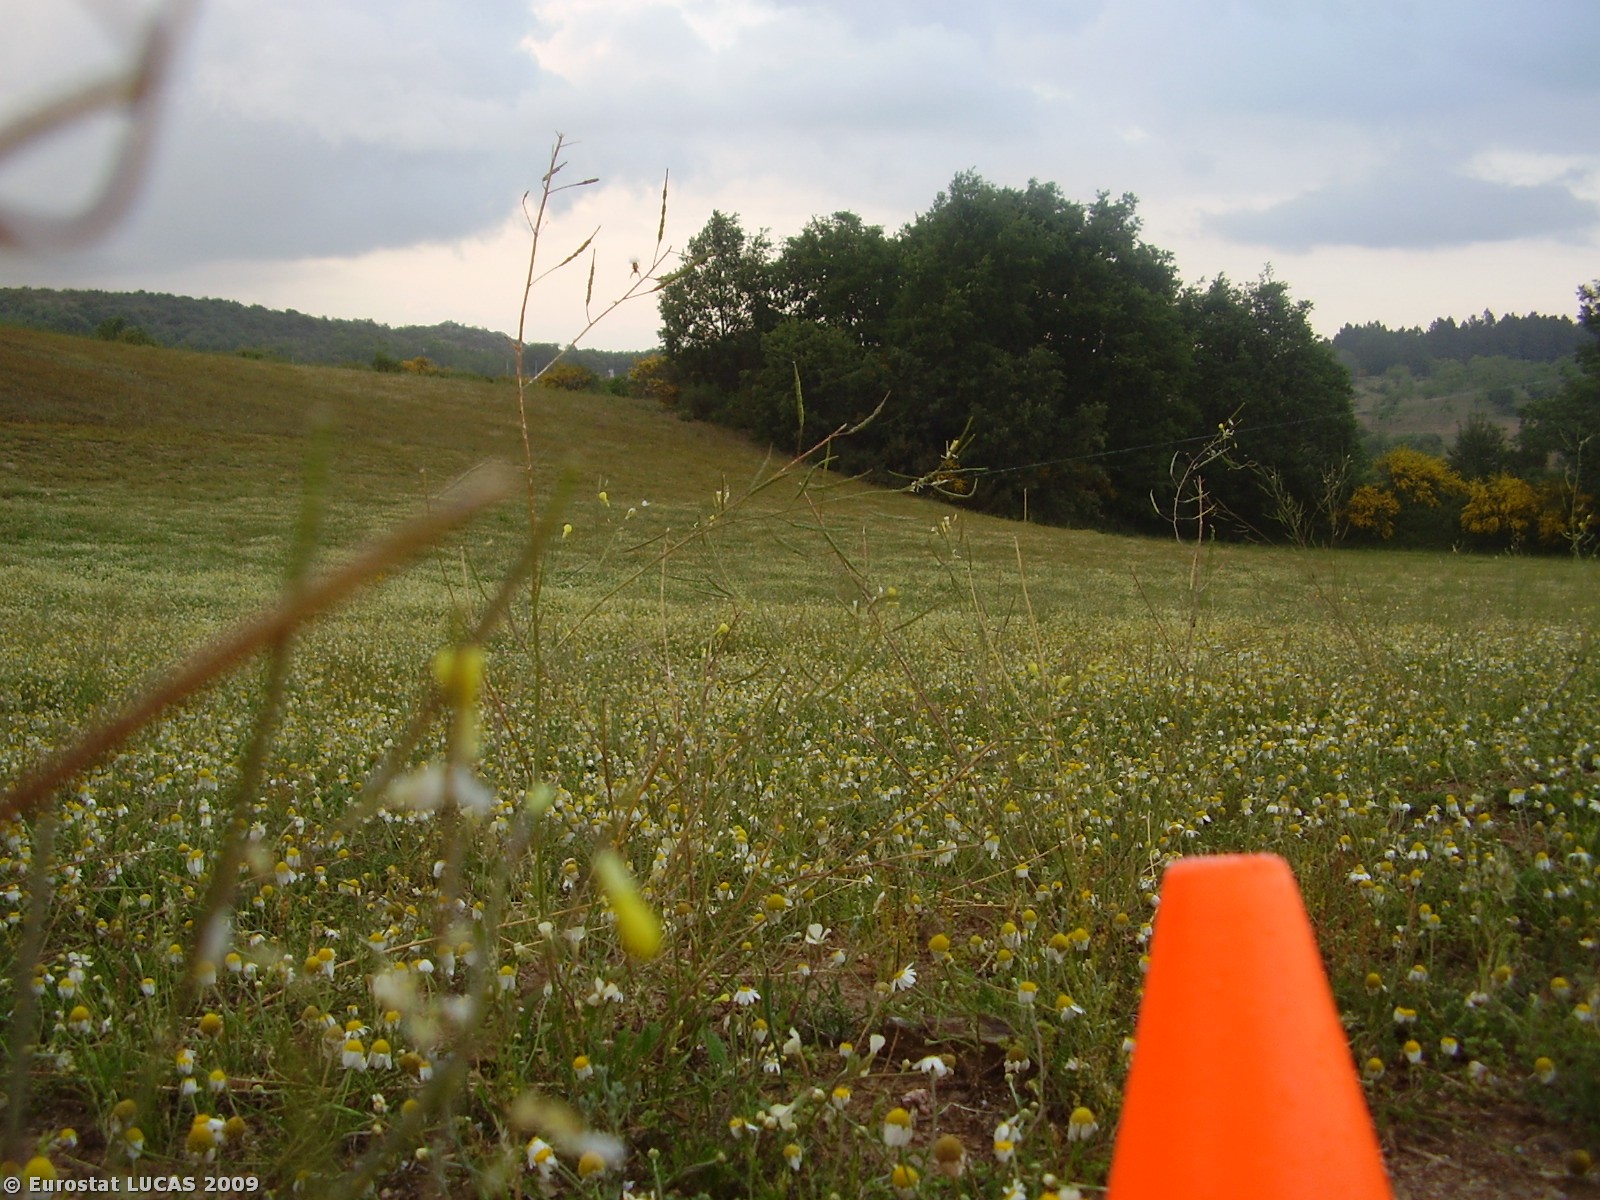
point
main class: Grassland
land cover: Grassland without tree/shrub cover
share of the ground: > 75 %
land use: Forestry
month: June
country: PT
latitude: 41.6595
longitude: -6.8170
